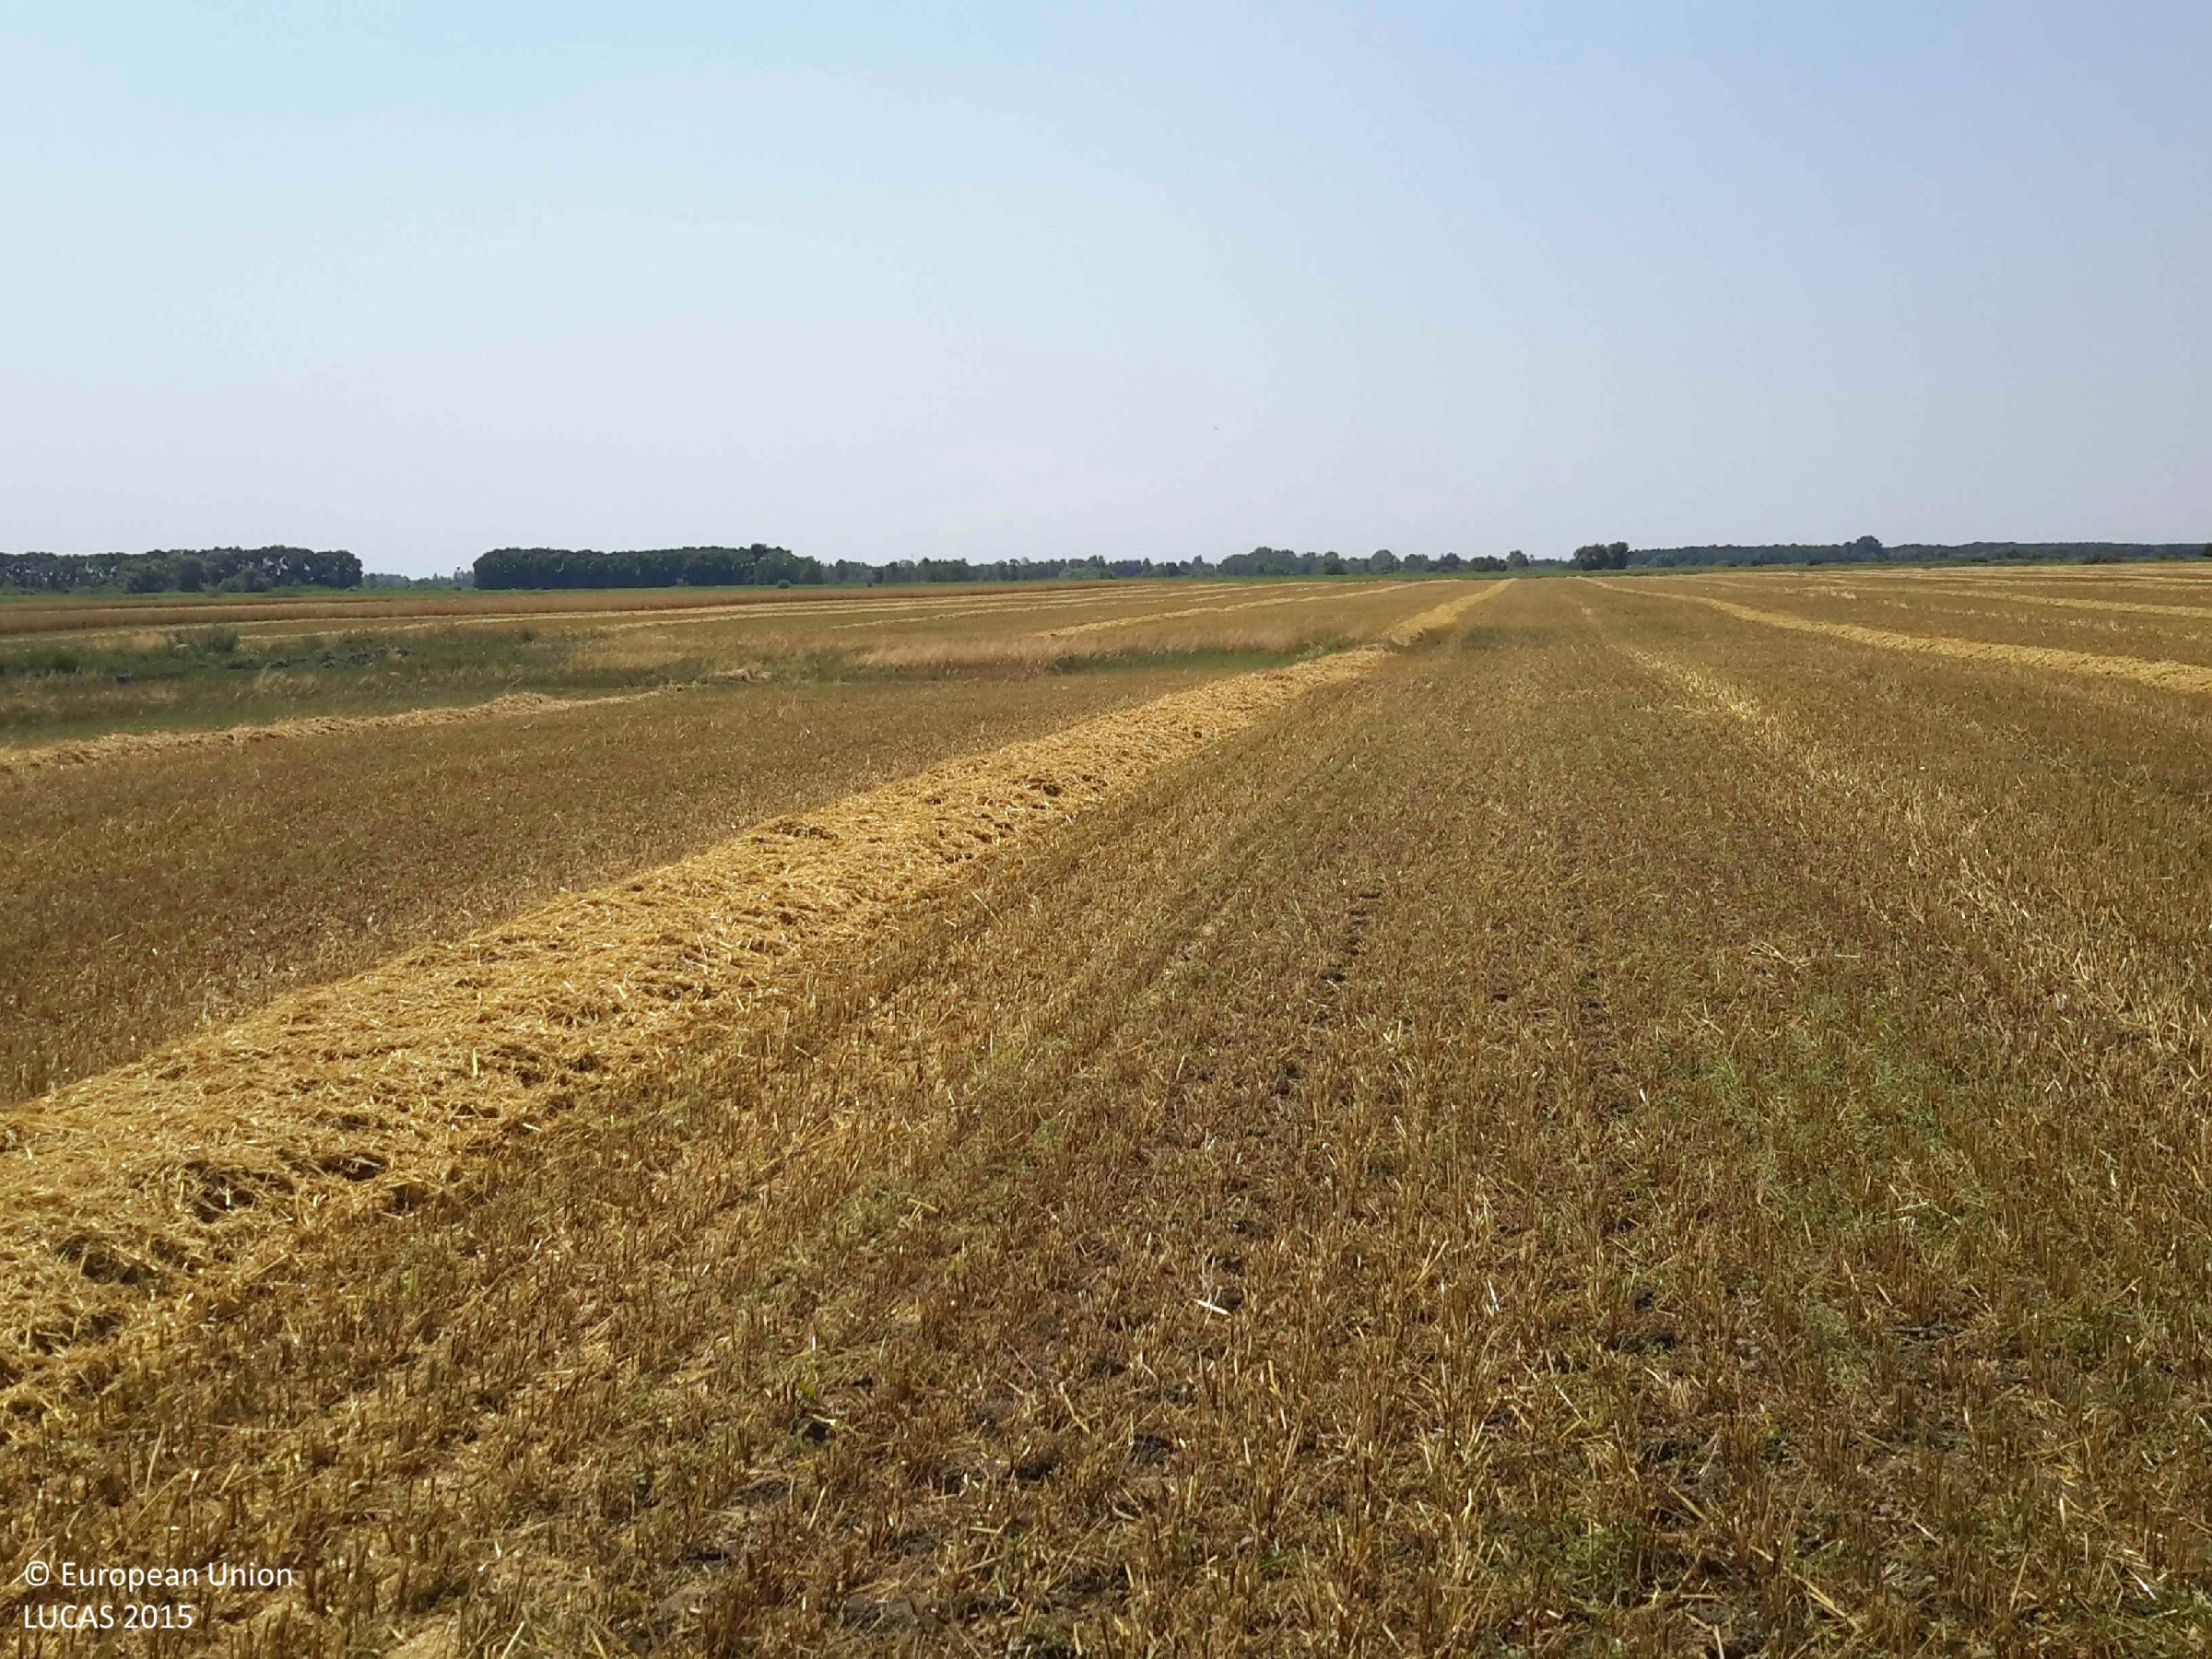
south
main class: Cropland
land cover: Barley
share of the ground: 25 - 50 %
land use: Agriculture (excluding fallow land and kitchen gardens)
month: July
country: HU
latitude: 47.3471
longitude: 17.3268
